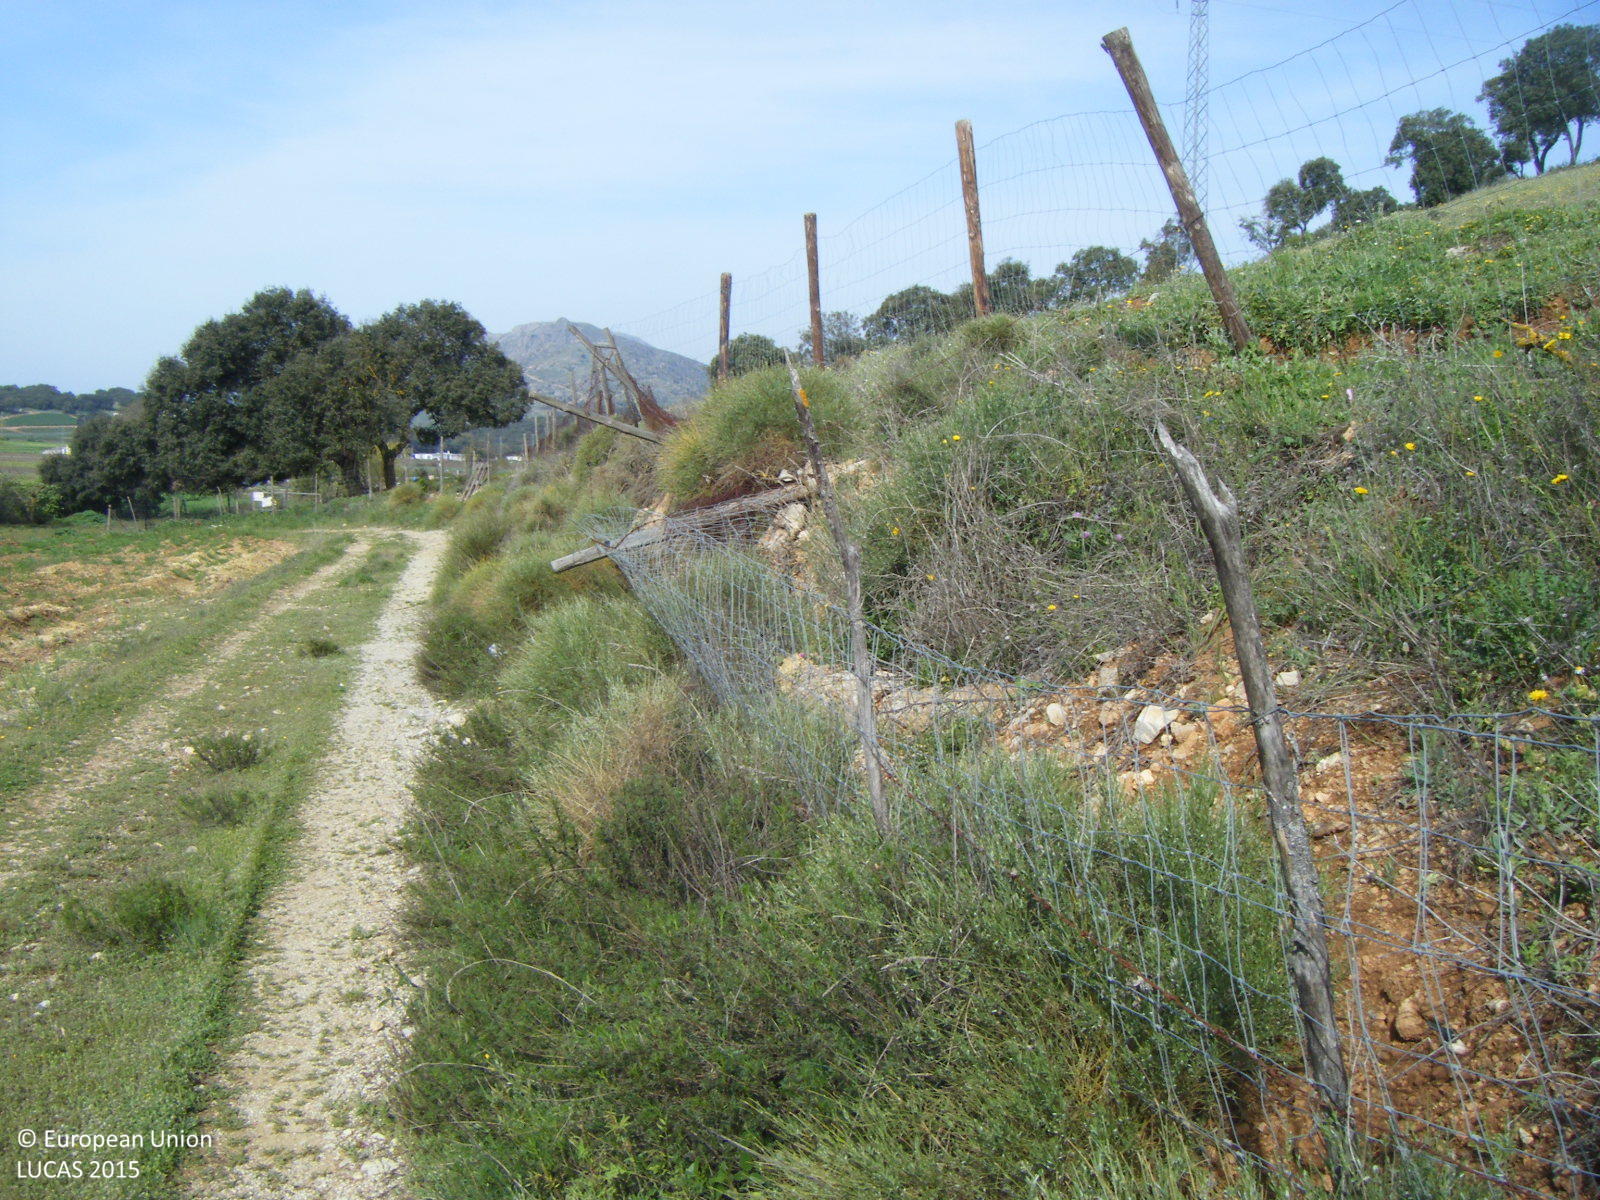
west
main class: Shrubland
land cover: Shrubland without tree cover
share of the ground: 25 - 50 %
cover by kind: herbaceous plants 60 %, shrubs 40 %
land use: Agriculture (excluding fallow land and kitchen gardens)
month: April
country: ES
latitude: 36.9543
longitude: -4.0617
